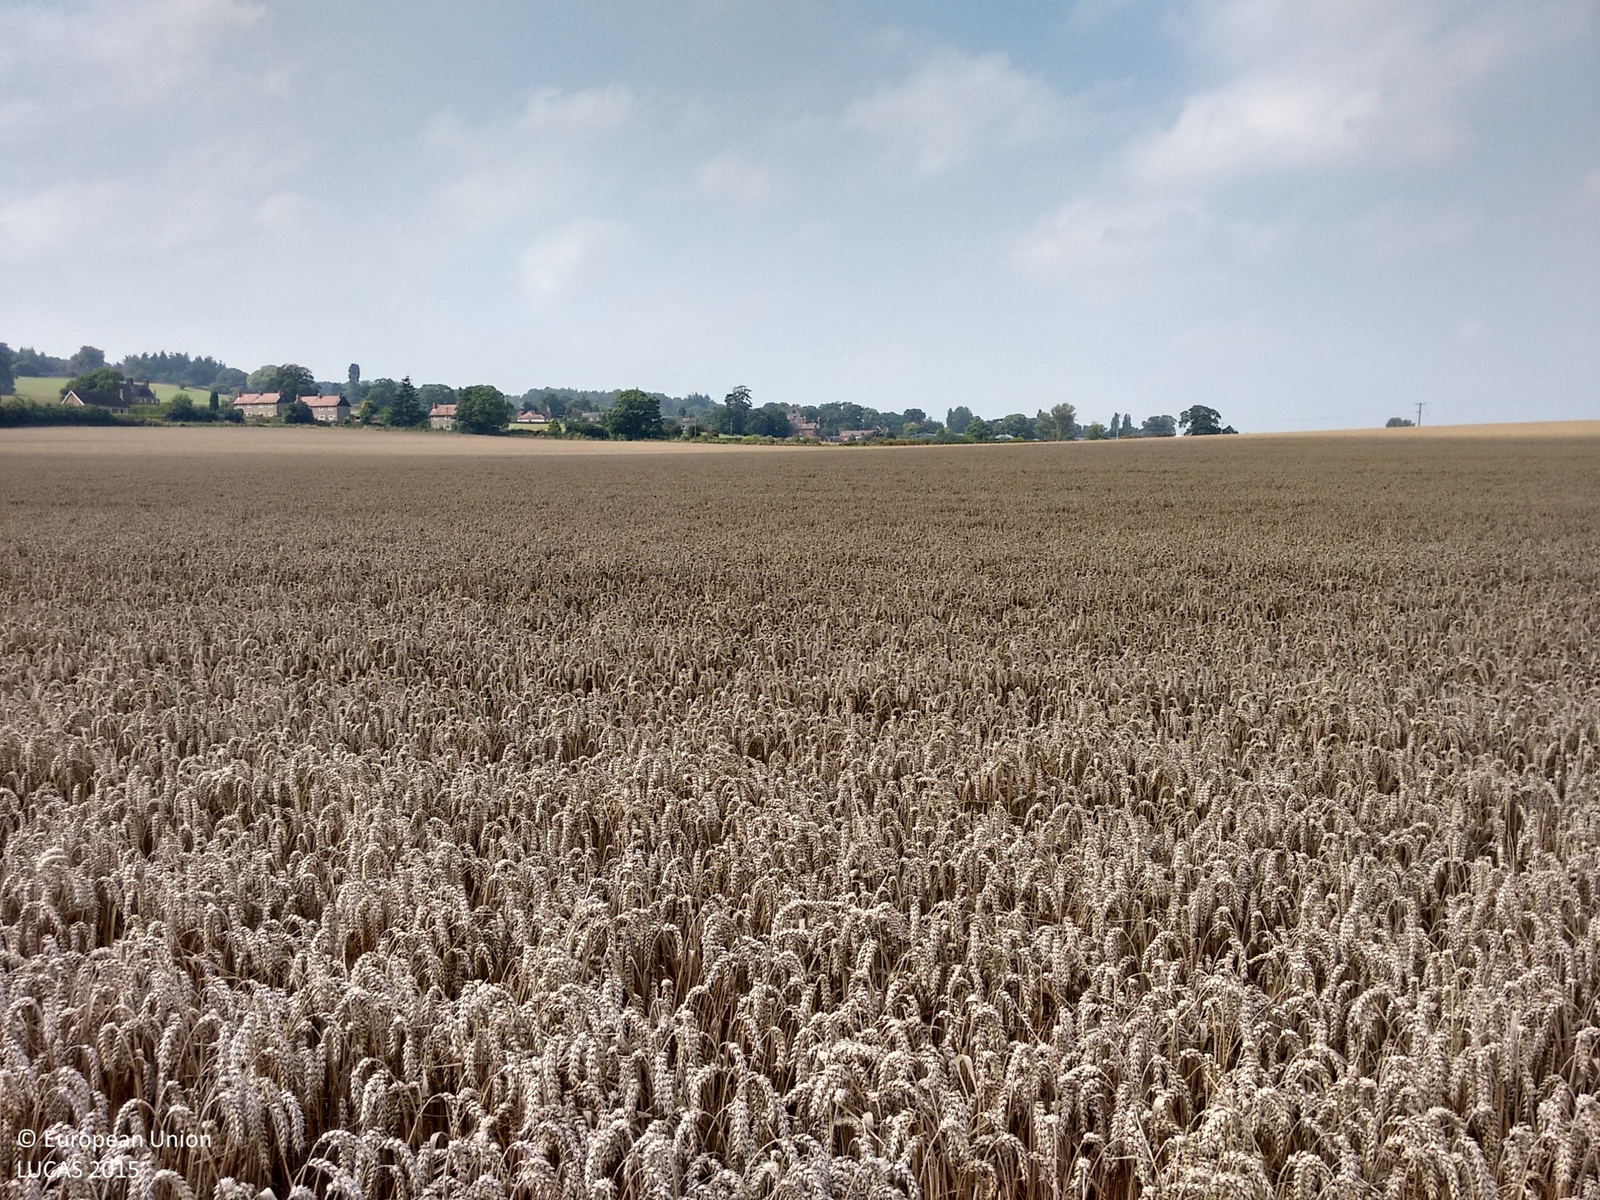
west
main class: Cropland
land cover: Common wheat
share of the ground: > 75 %
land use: Agriculture (excluding fallow land and kitchen gardens)
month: September
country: GB
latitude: 52.7221
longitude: -2.9398
